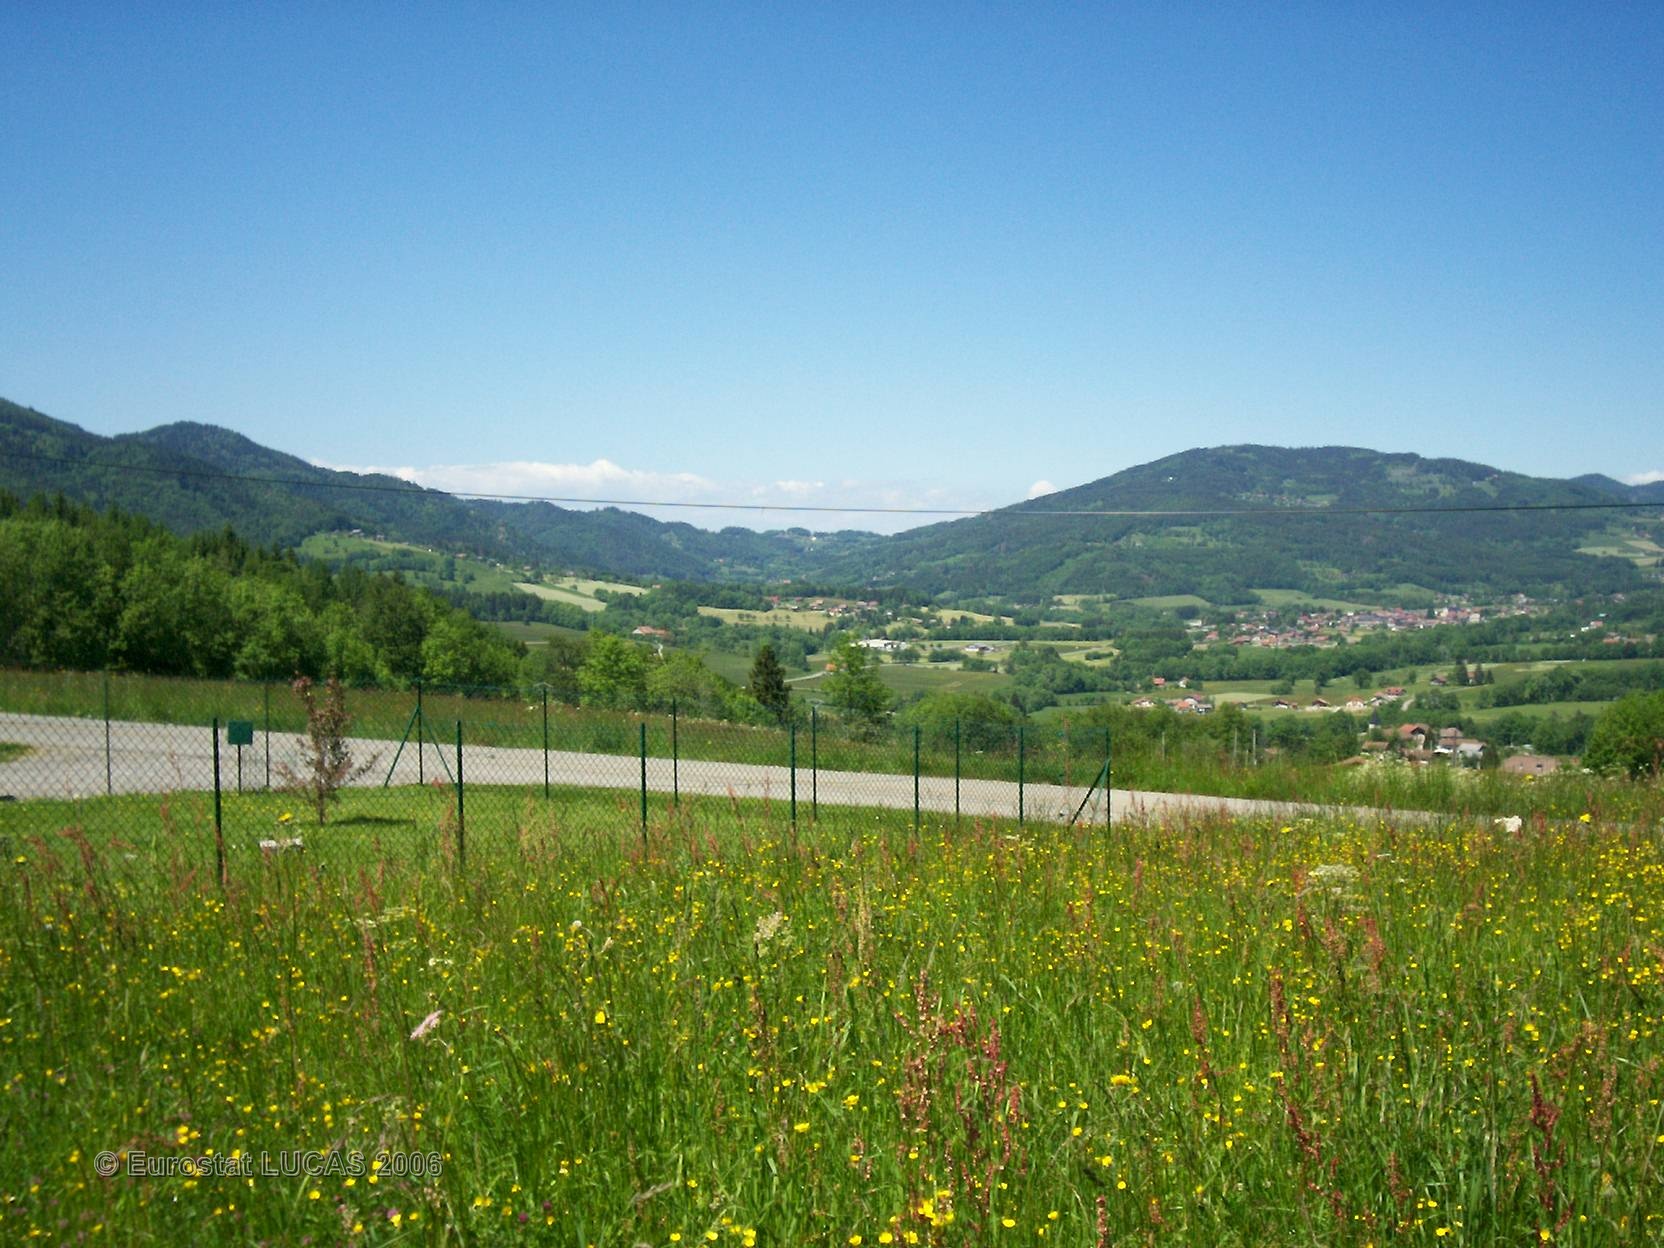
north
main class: Grassland
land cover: Grassland without tree/shrub cover
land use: Agriculture (excluding fallow land and kitchen gardens)
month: June
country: FR
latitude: 46.1821
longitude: 6.3891
